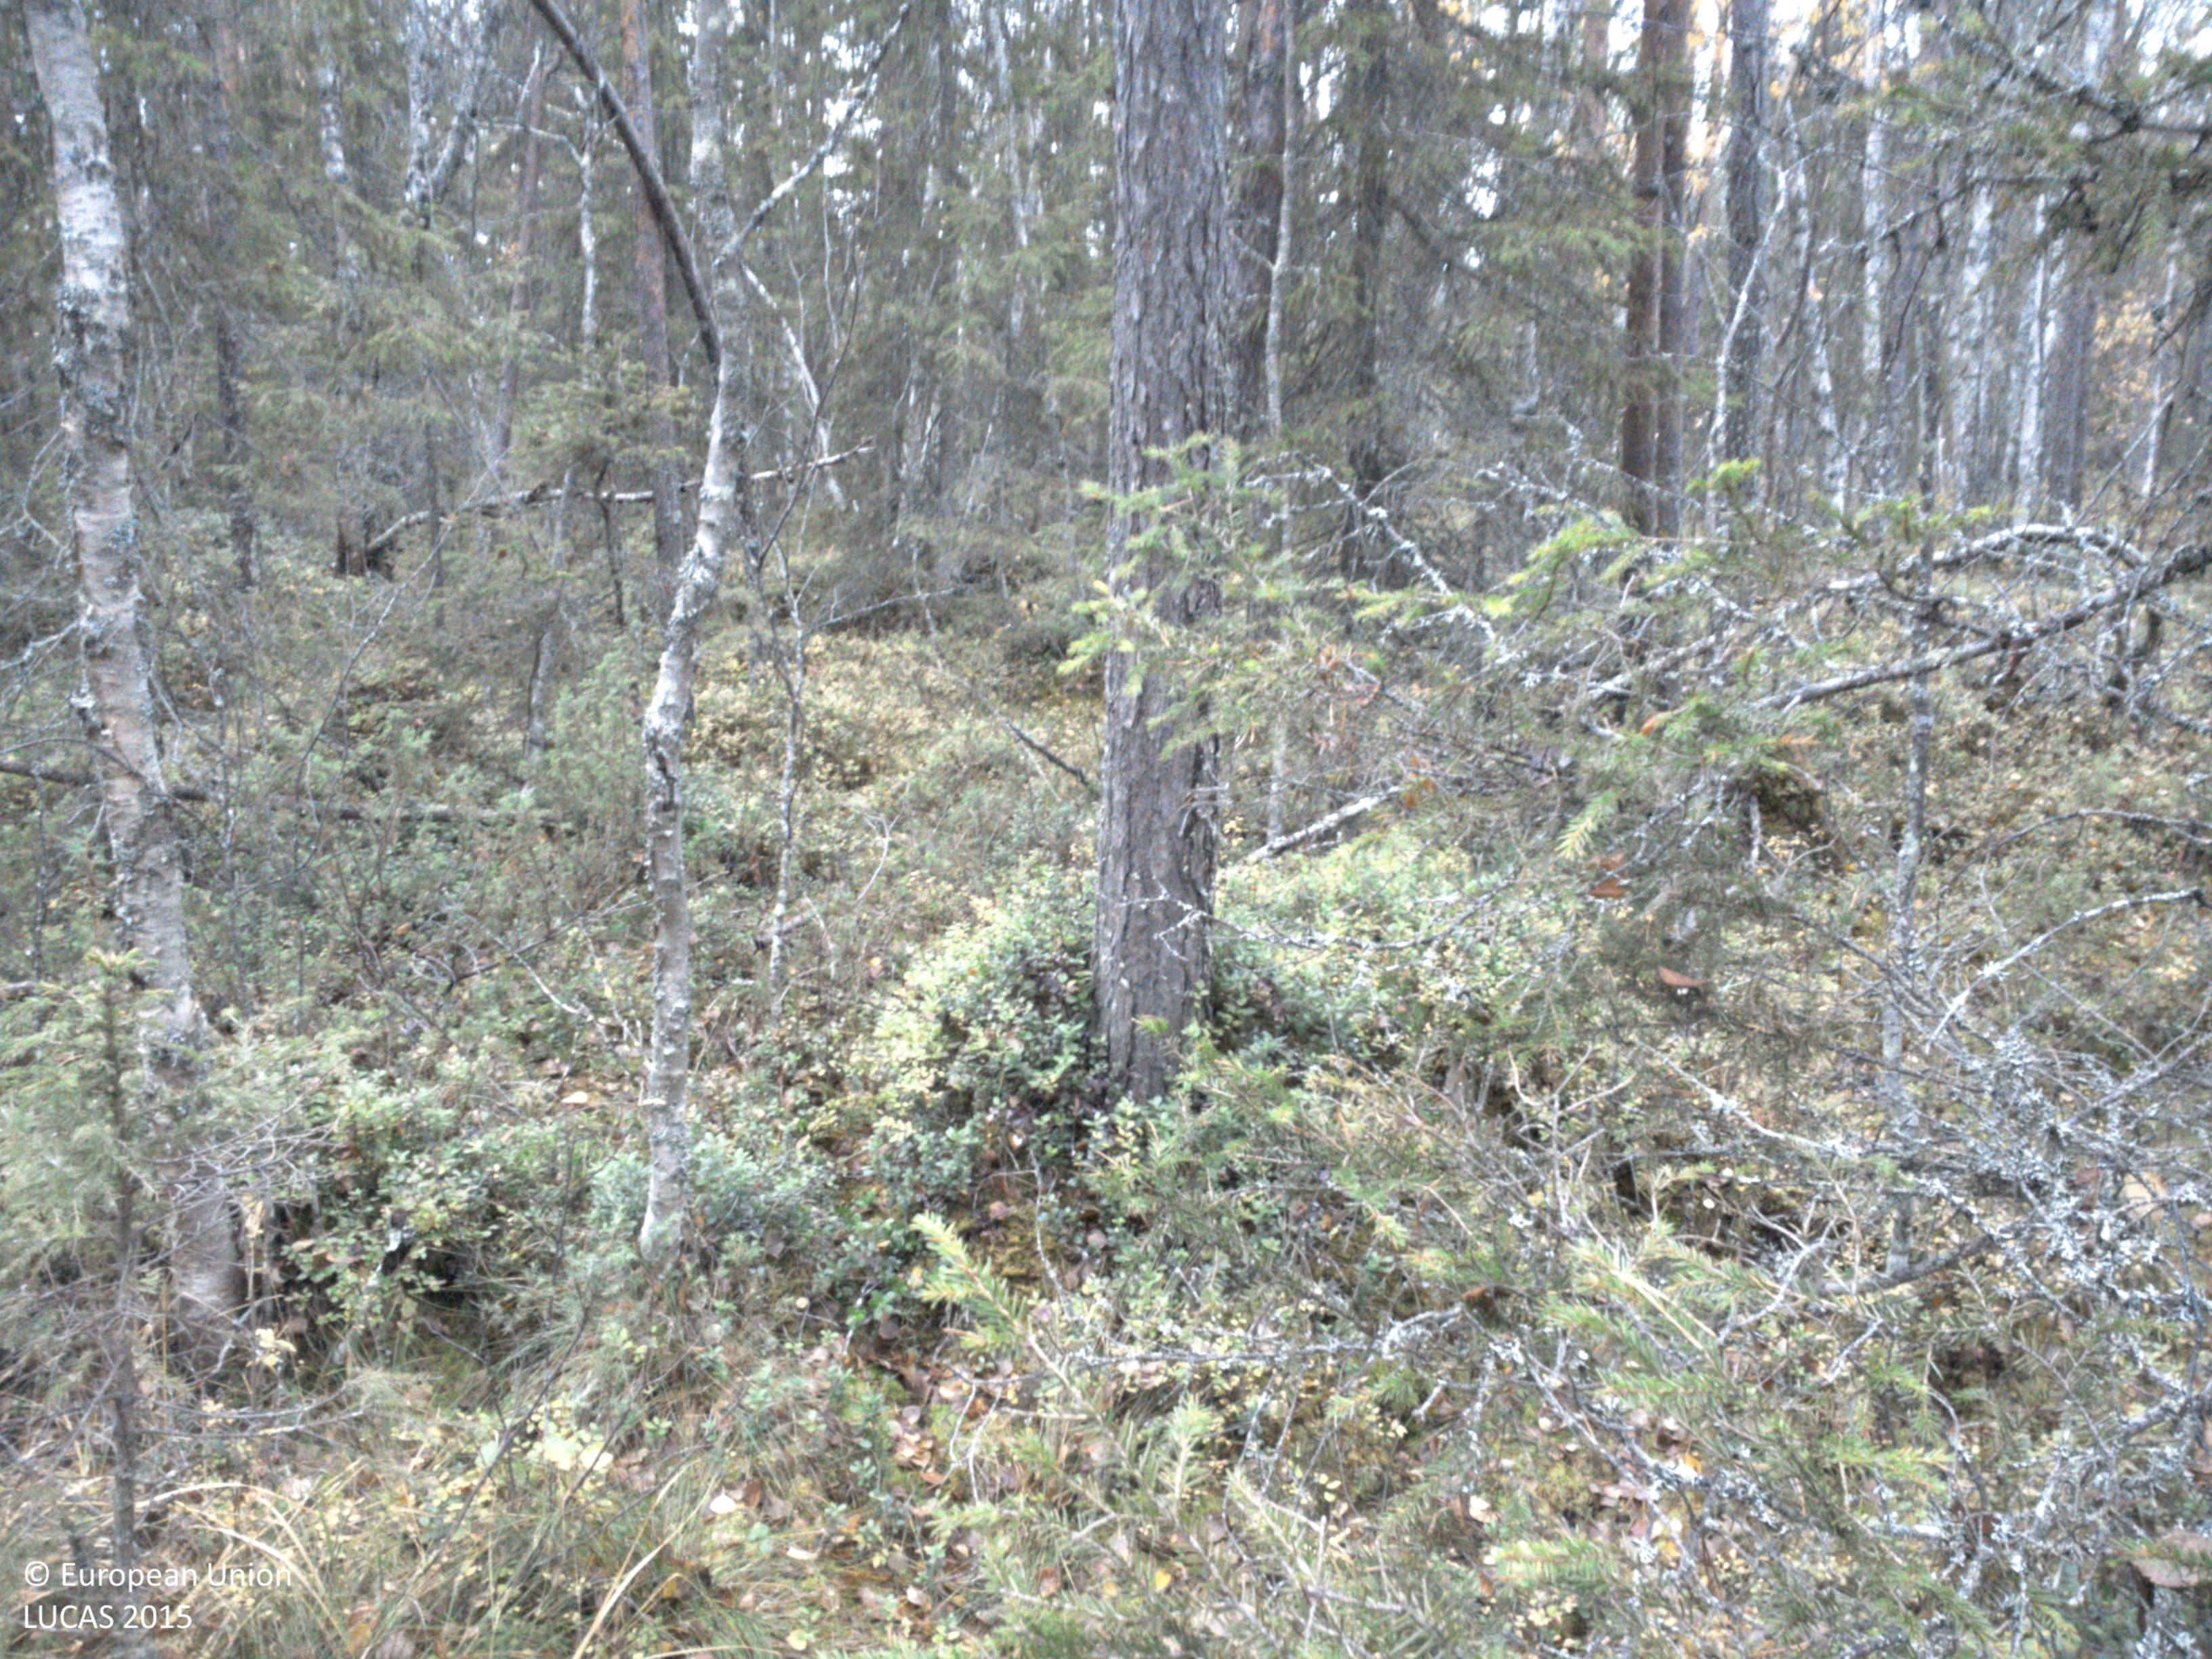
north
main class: Woodland
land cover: Pine dominated mixed woodland
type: boreal forest
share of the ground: > 75 %
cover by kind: coniferous forest trees 60 %, broadleaved forest trees 20 %, shrubs 10 %, herbaceous plants 5 %, lichens and mosses 5 %
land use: Forestry
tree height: > 5 m
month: September
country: SE
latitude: 64.8404
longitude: 18.8837
